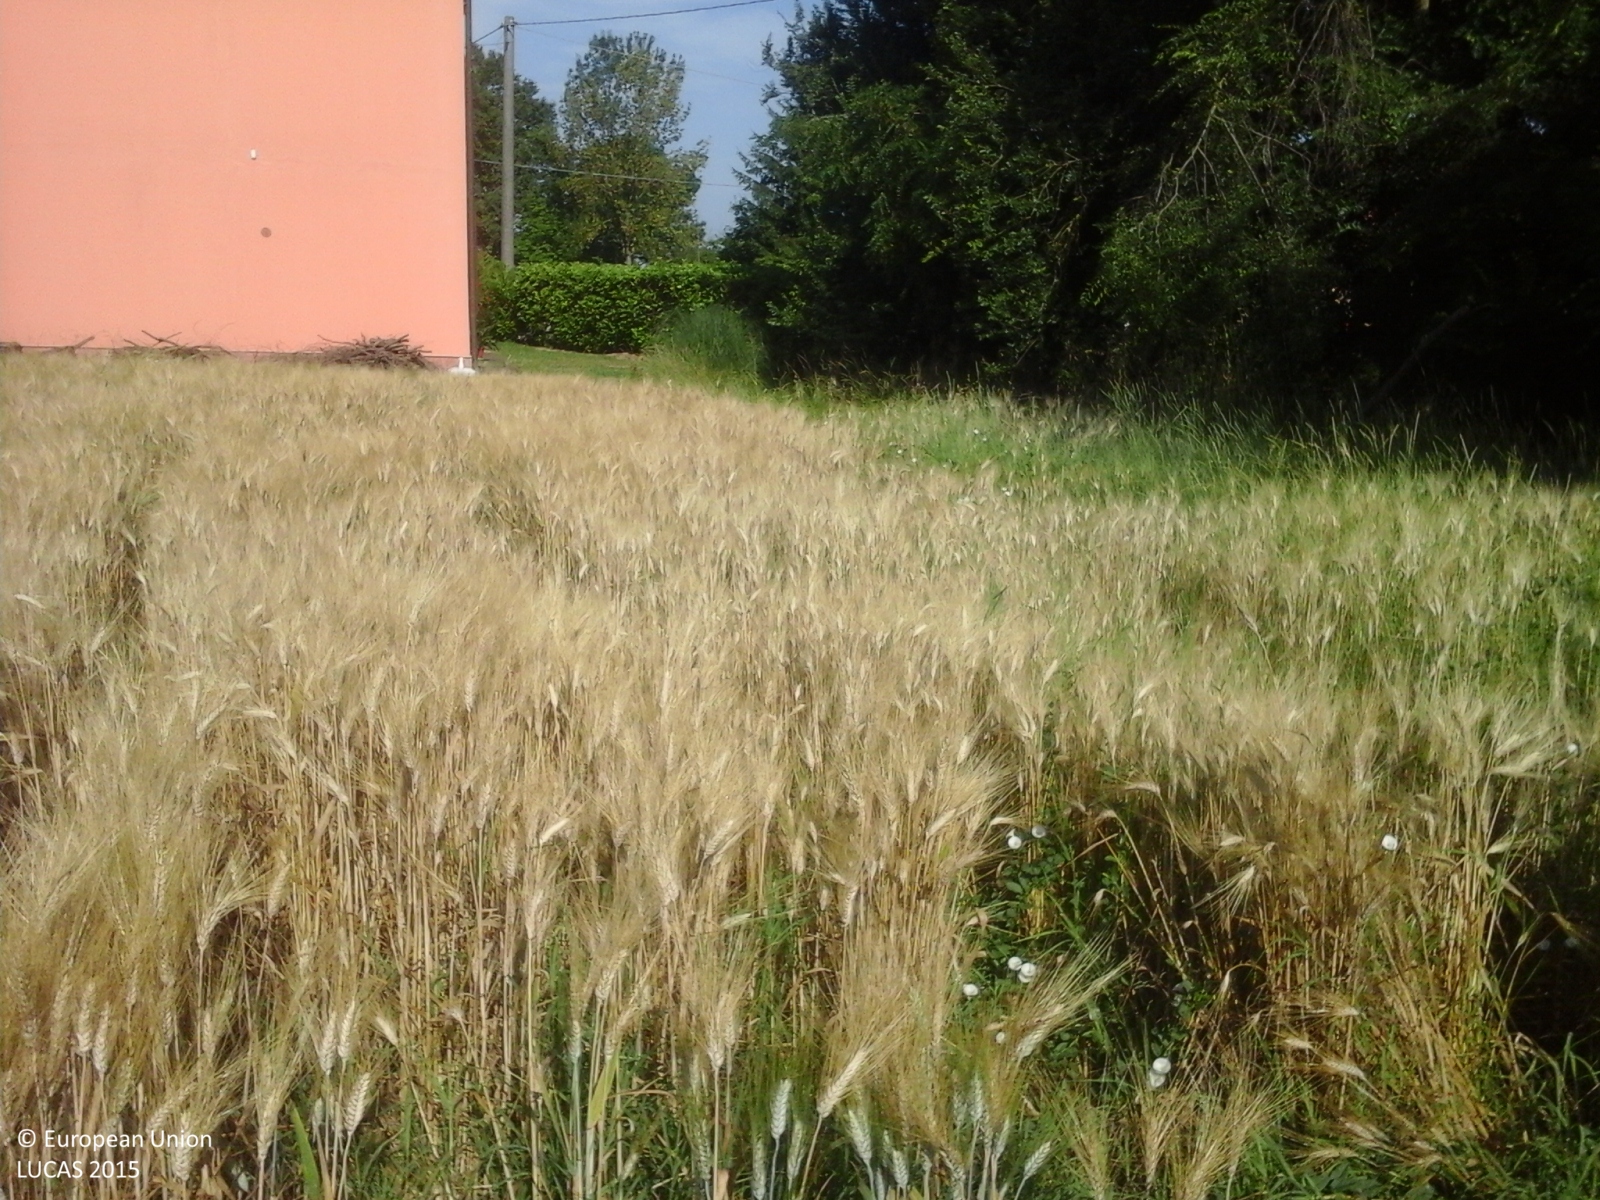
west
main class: Cropland
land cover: Common wheat
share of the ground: > 75 %
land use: Agriculture (excluding fallow land and kitchen gardens)
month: June
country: IT
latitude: 44.8875
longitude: 10.9224
